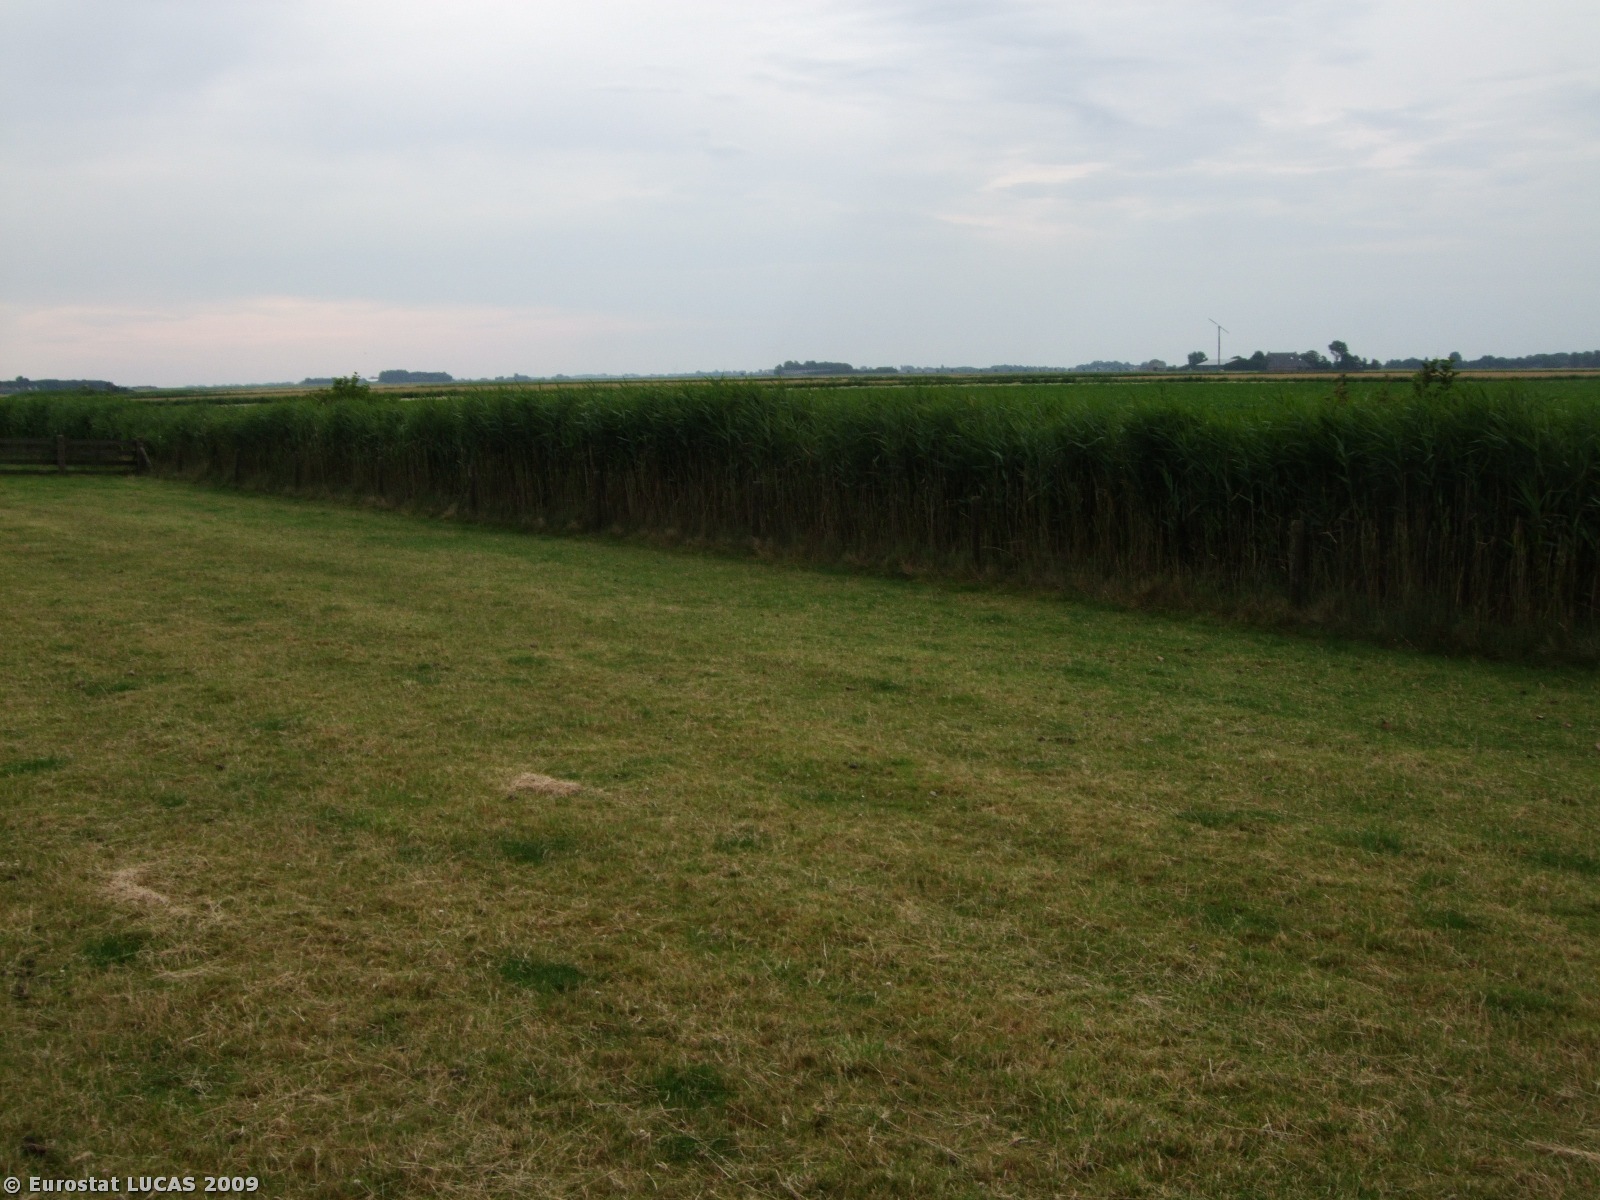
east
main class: Grassland
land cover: Grassland without tree/shrub cover
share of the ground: > 75 %
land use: Protection infrastructures
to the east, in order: Grassland without tree/shrub cover; Fences; Grass margins; Inland running water; Grass margins; Sugar beet; Ditches and canals; Common wheat
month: July
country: NL
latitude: 53.3041
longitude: 5.6021
